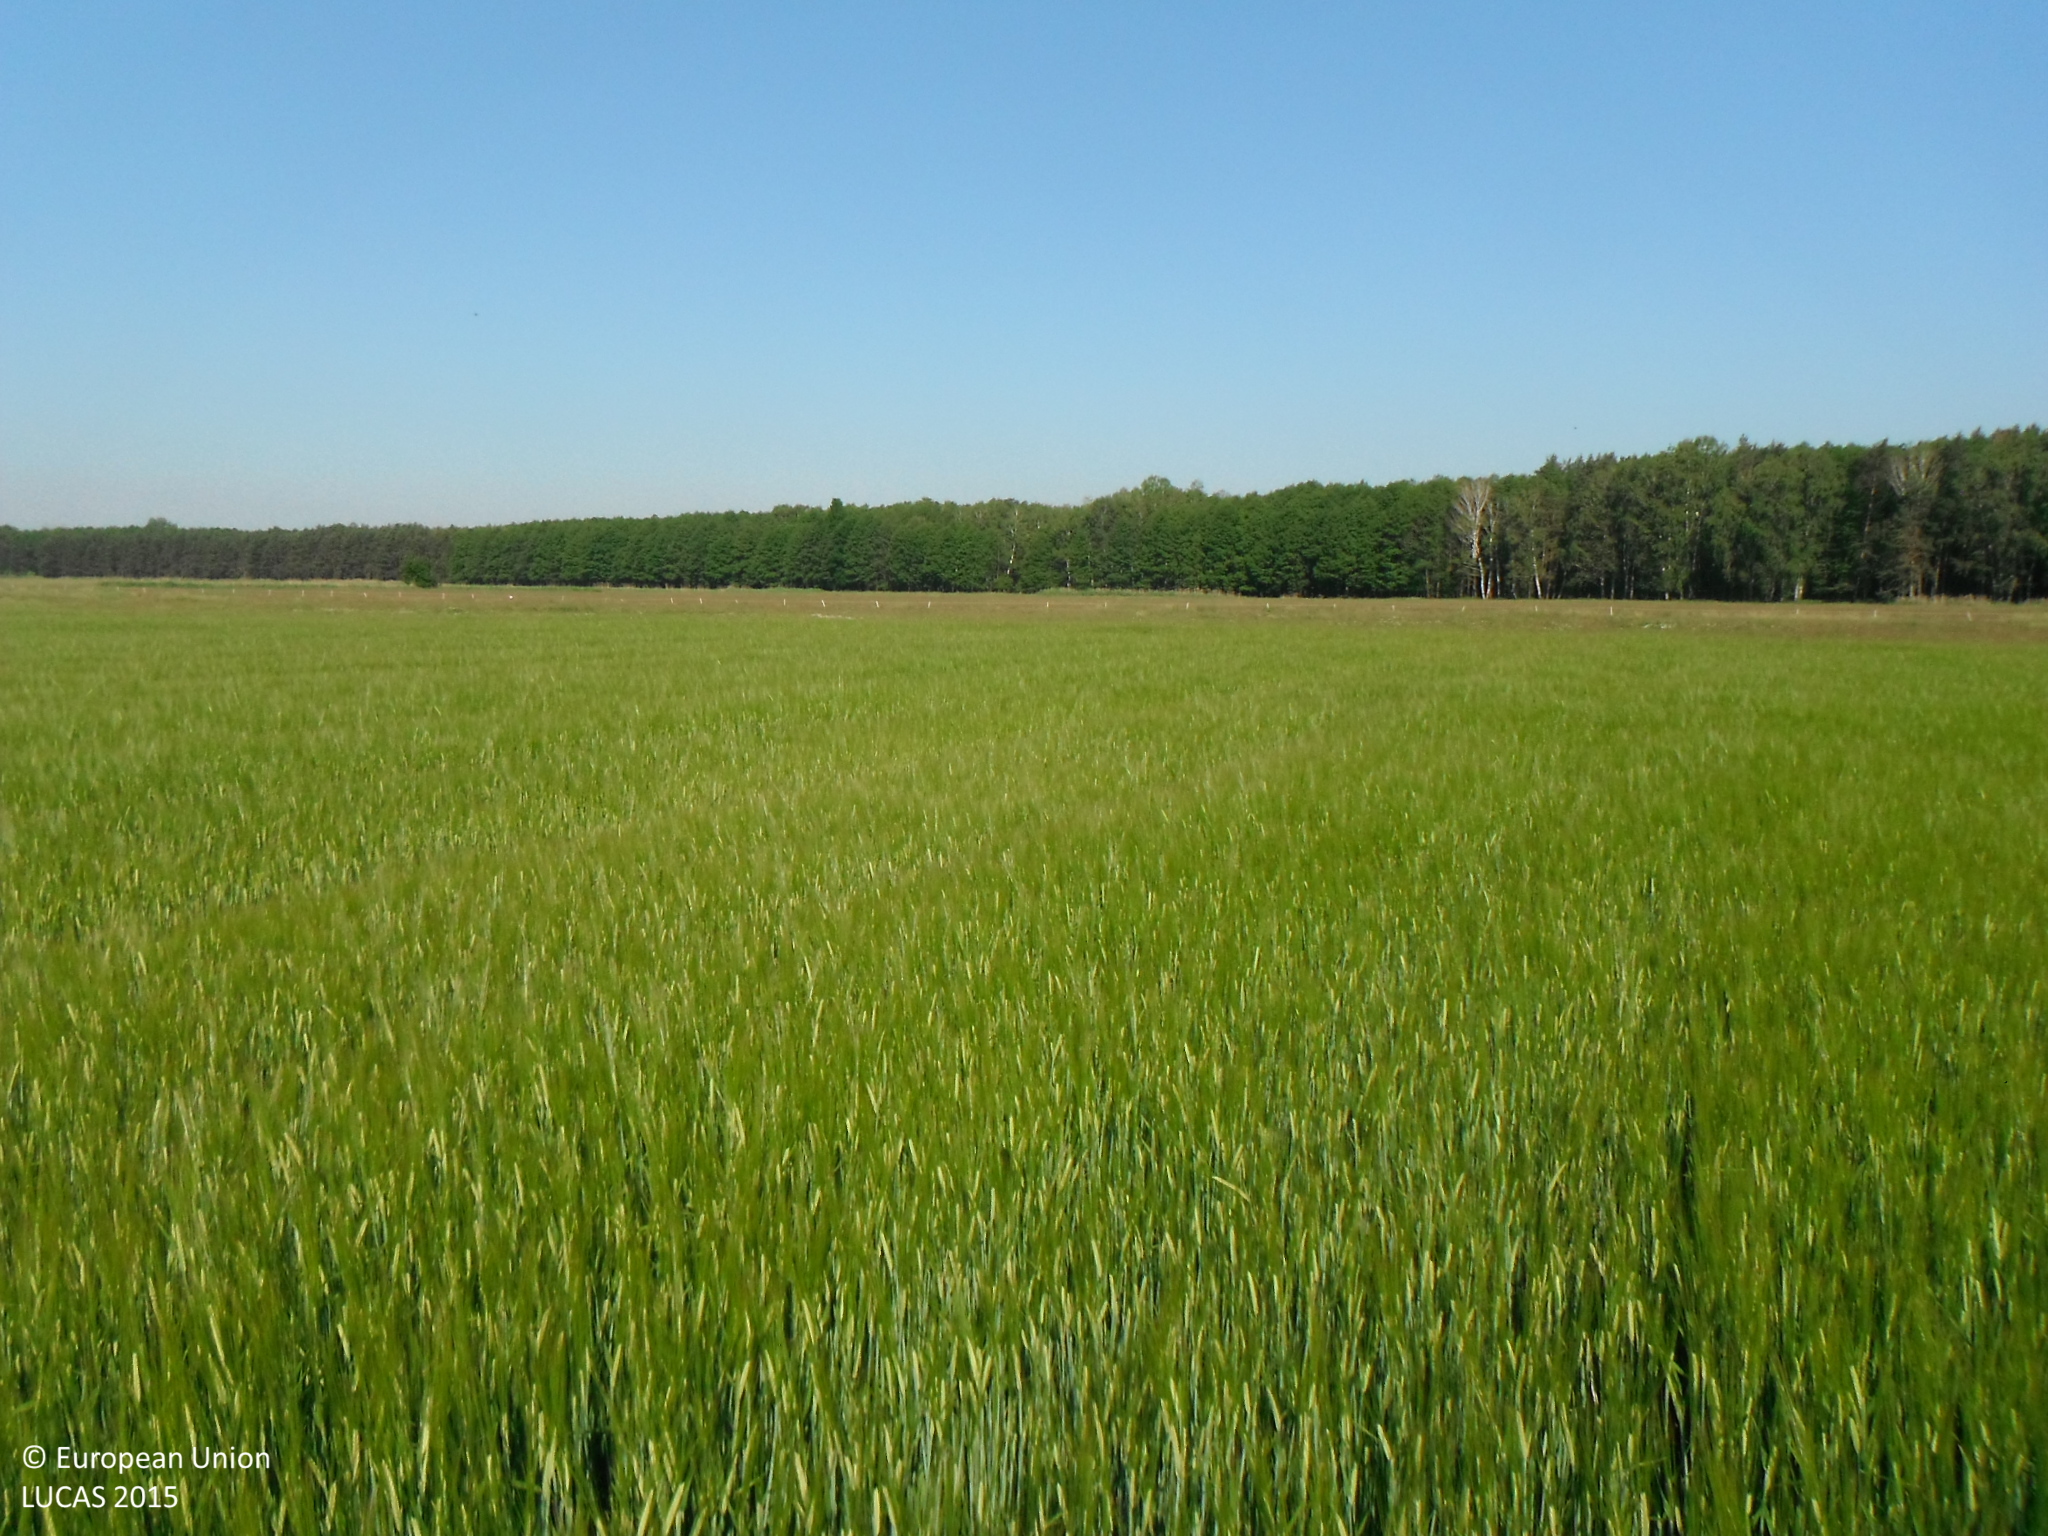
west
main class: Cropland
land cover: Barley
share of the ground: > 75 %
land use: Agriculture (excluding fallow land and kitchen gardens)
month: June
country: SK
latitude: 48.5425
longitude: 17.2833
